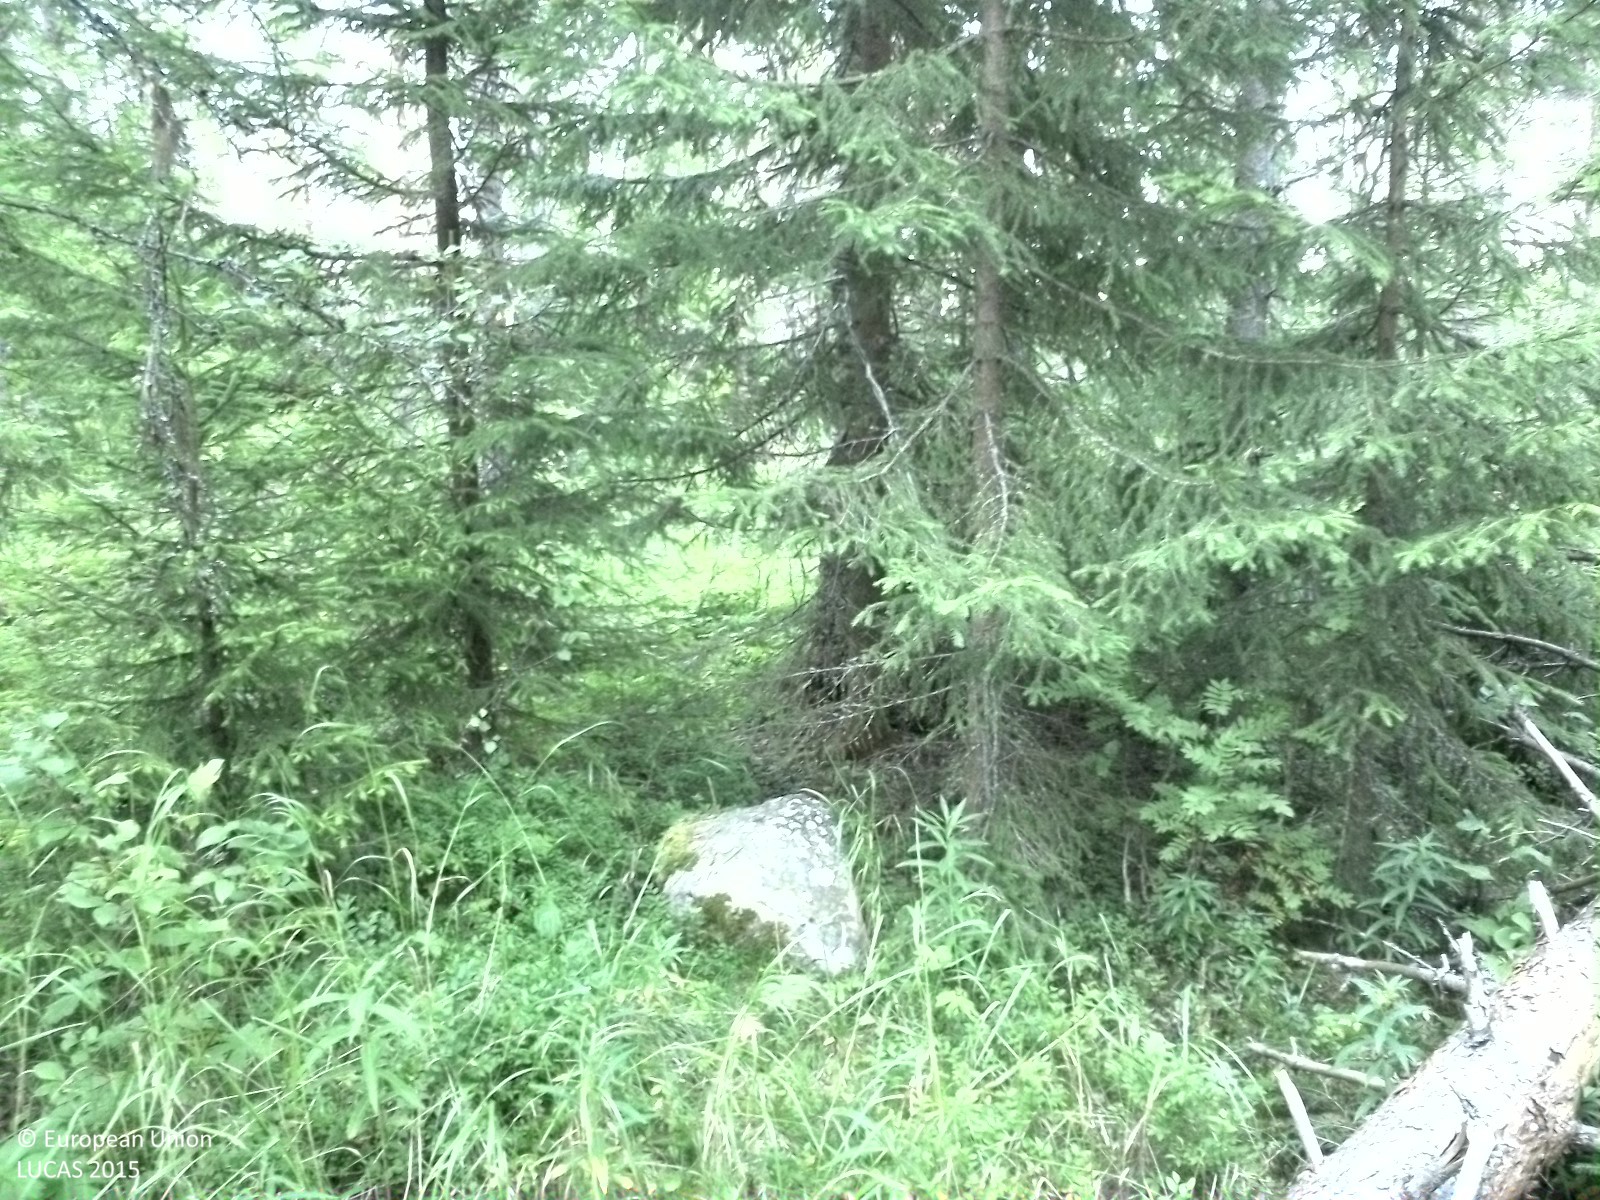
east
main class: Woodland
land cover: Other mixed woodland
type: boreal forest
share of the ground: 25 - 50 %
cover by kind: shrubs 55 %, coniferous forest trees 30 %, broadleaved forest trees 15 %
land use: Forestry
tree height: > 5 m
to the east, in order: Other mixed woodland; Pine dominated coniferous woodland; Other coniferous woodland; Spruce dominated coniferous woodland
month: August
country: SE
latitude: 62.2040
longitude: 16.4202
